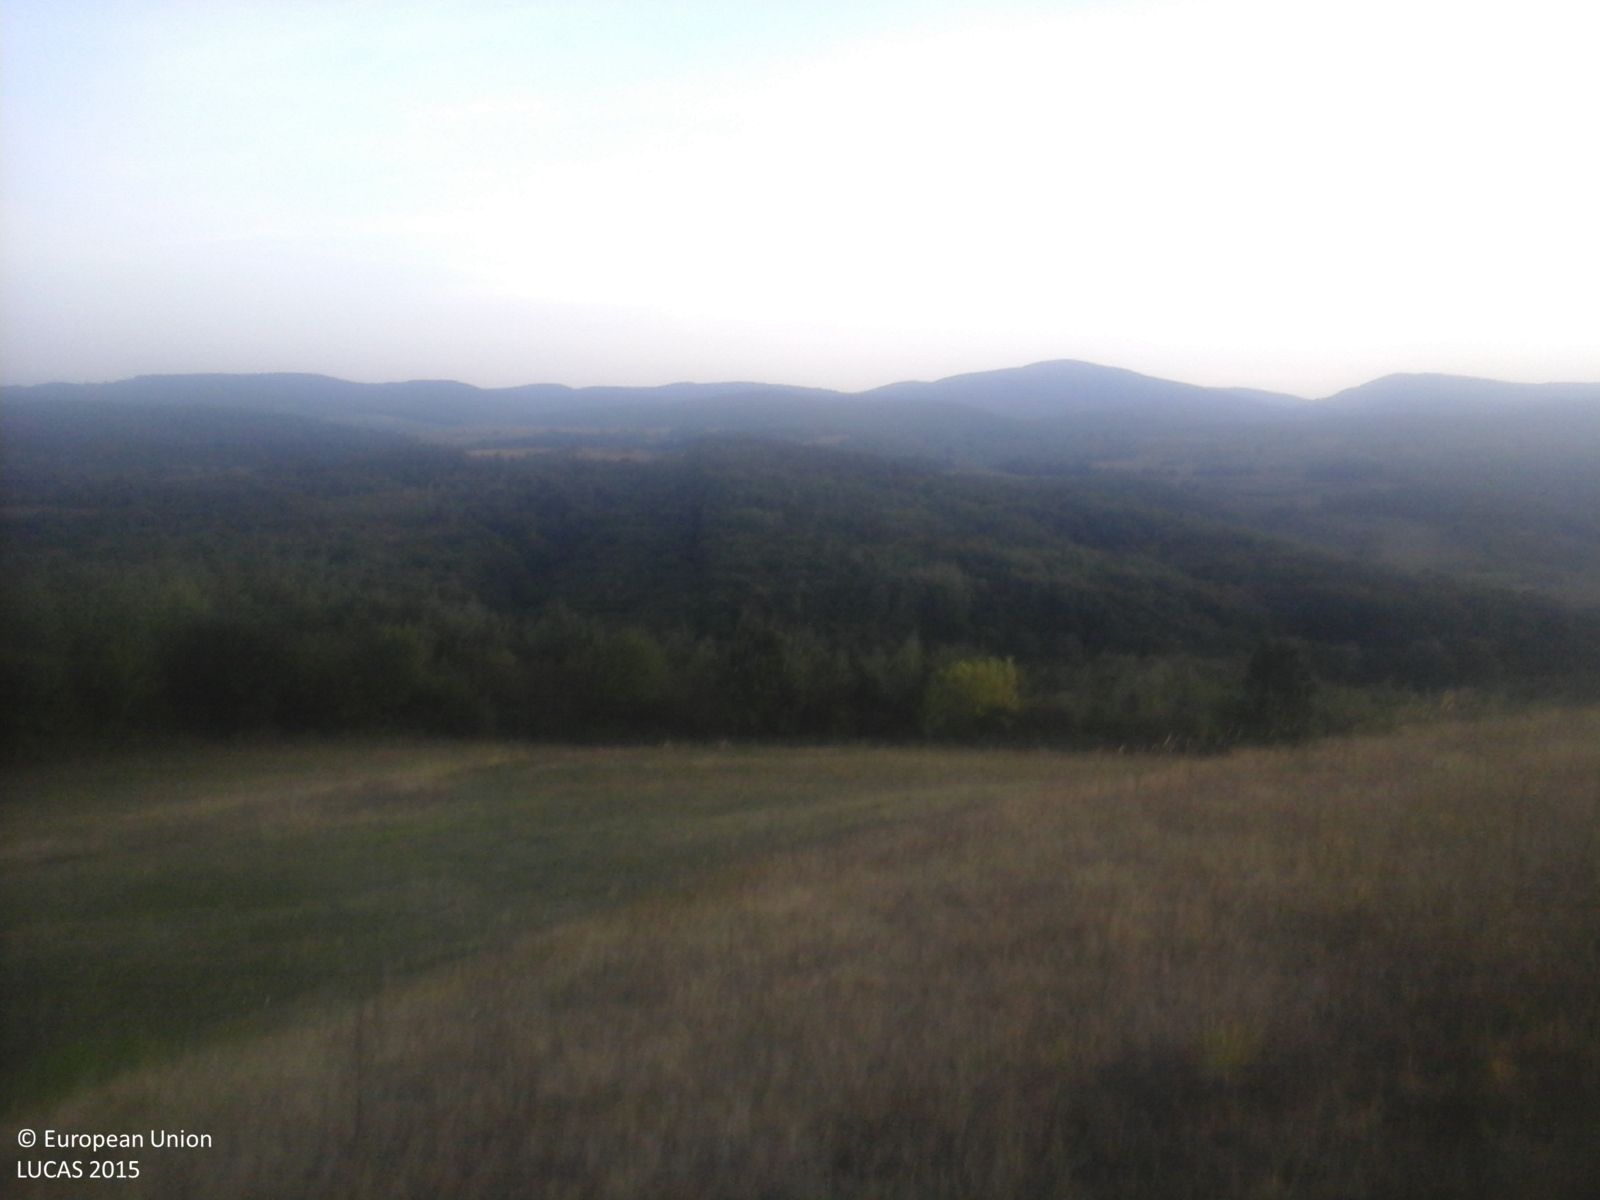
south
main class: Grassland
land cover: Spontaneously vegetated surfaces
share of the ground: > 75 %
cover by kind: herbaceous plants 100 %
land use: Fallow land
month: September
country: RO
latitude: 46.5935
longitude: 22.3850
